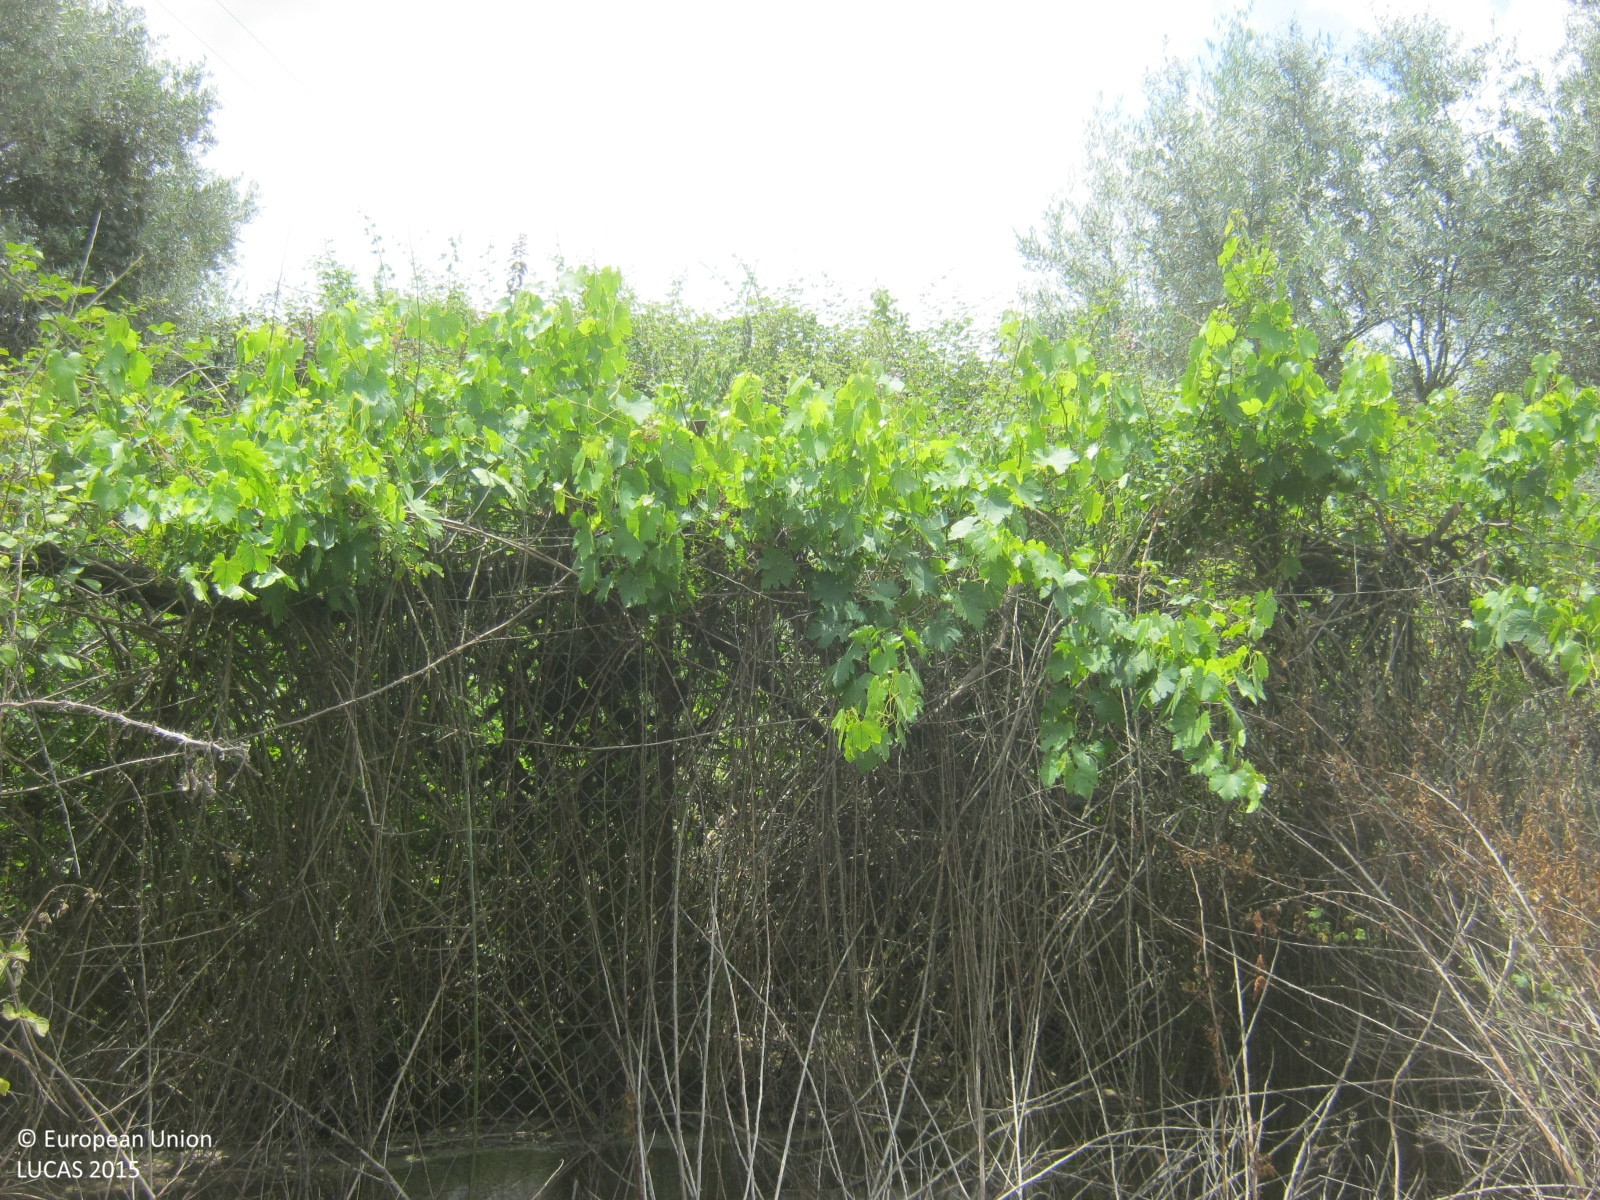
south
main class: Cropland
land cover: Olive groves
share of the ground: 50 - 75 %
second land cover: Grassland without tree/shrub cover
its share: > 75 %
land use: Abandoned areas
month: June
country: CY
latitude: 35.0452
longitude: 32.8972
